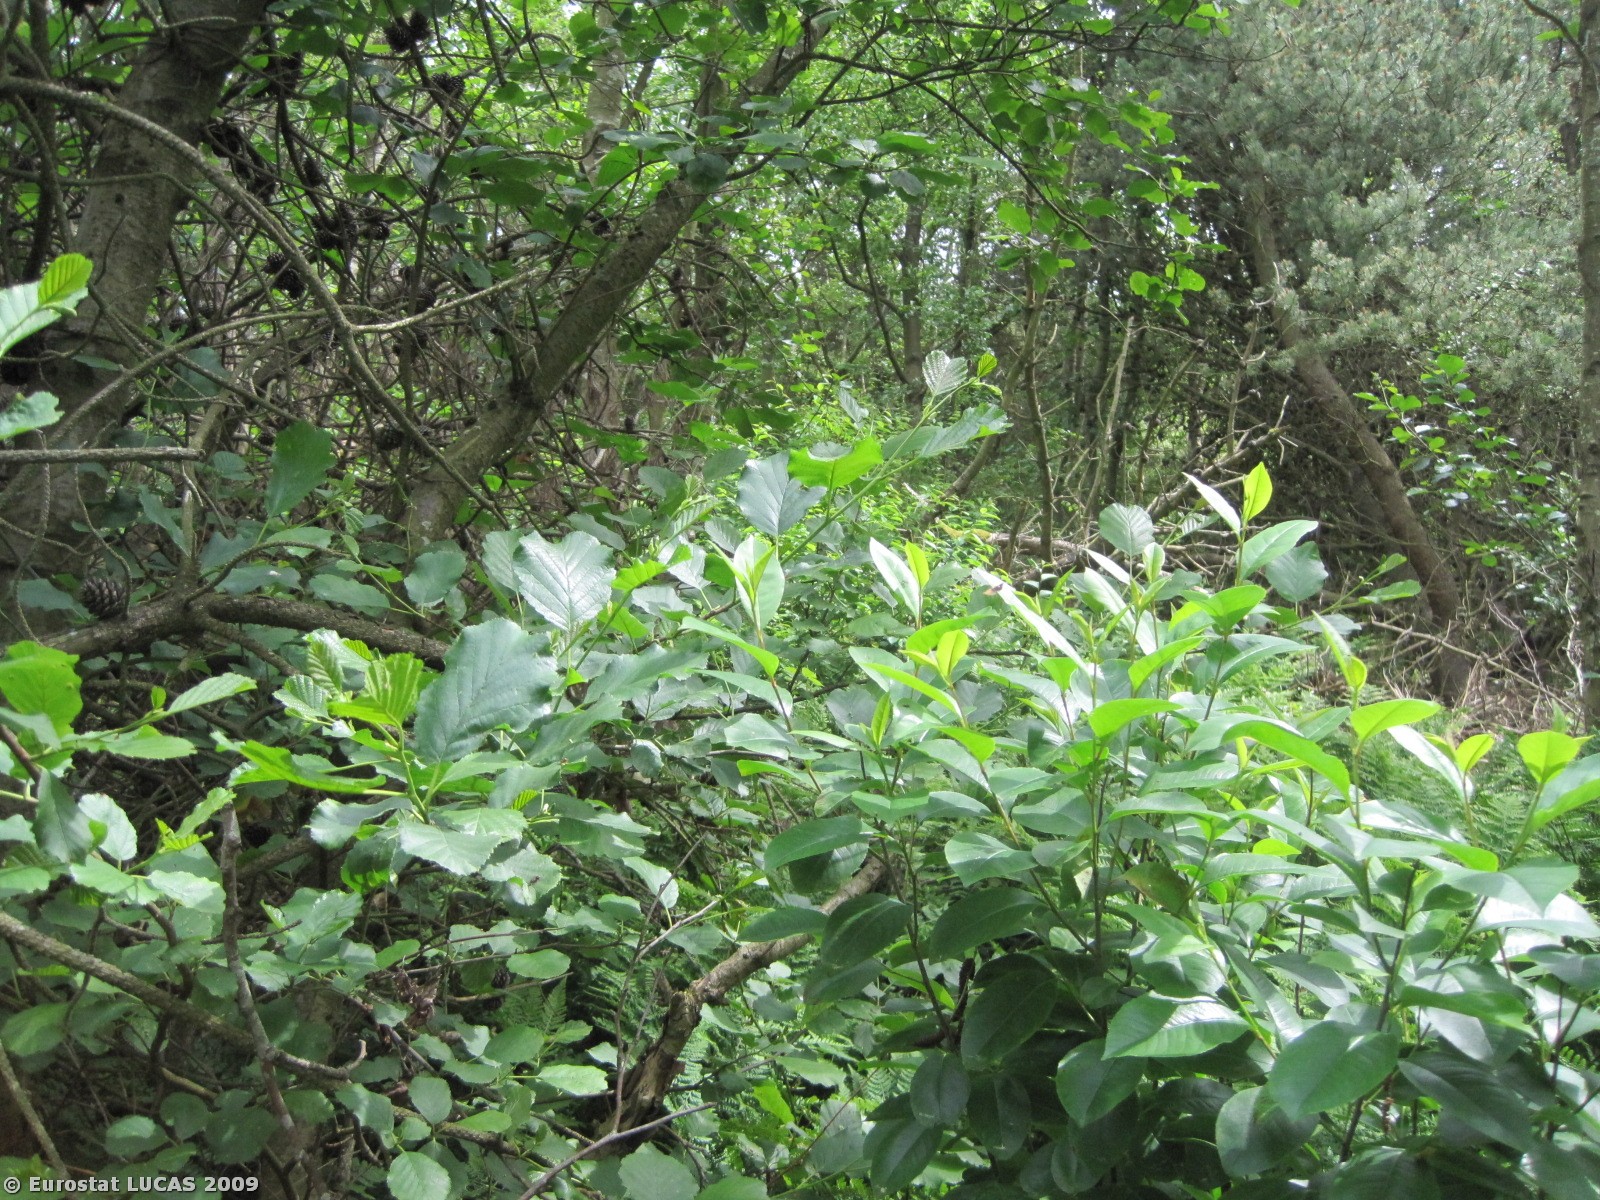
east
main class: Woodland
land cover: Mixed woodland
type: plantations and self-sown exotic forest
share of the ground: 50 - 75 %
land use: Forestry
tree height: > 5 m
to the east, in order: Mixed woodland; Ditches and canals; Grassland without tree/shrub cover; Coniferous woodland; Spontaneously vegetated surfaces; Tracks; Spontaneously vegetated surfaces
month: June
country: DK
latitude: 57.3560
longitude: 9.7179
